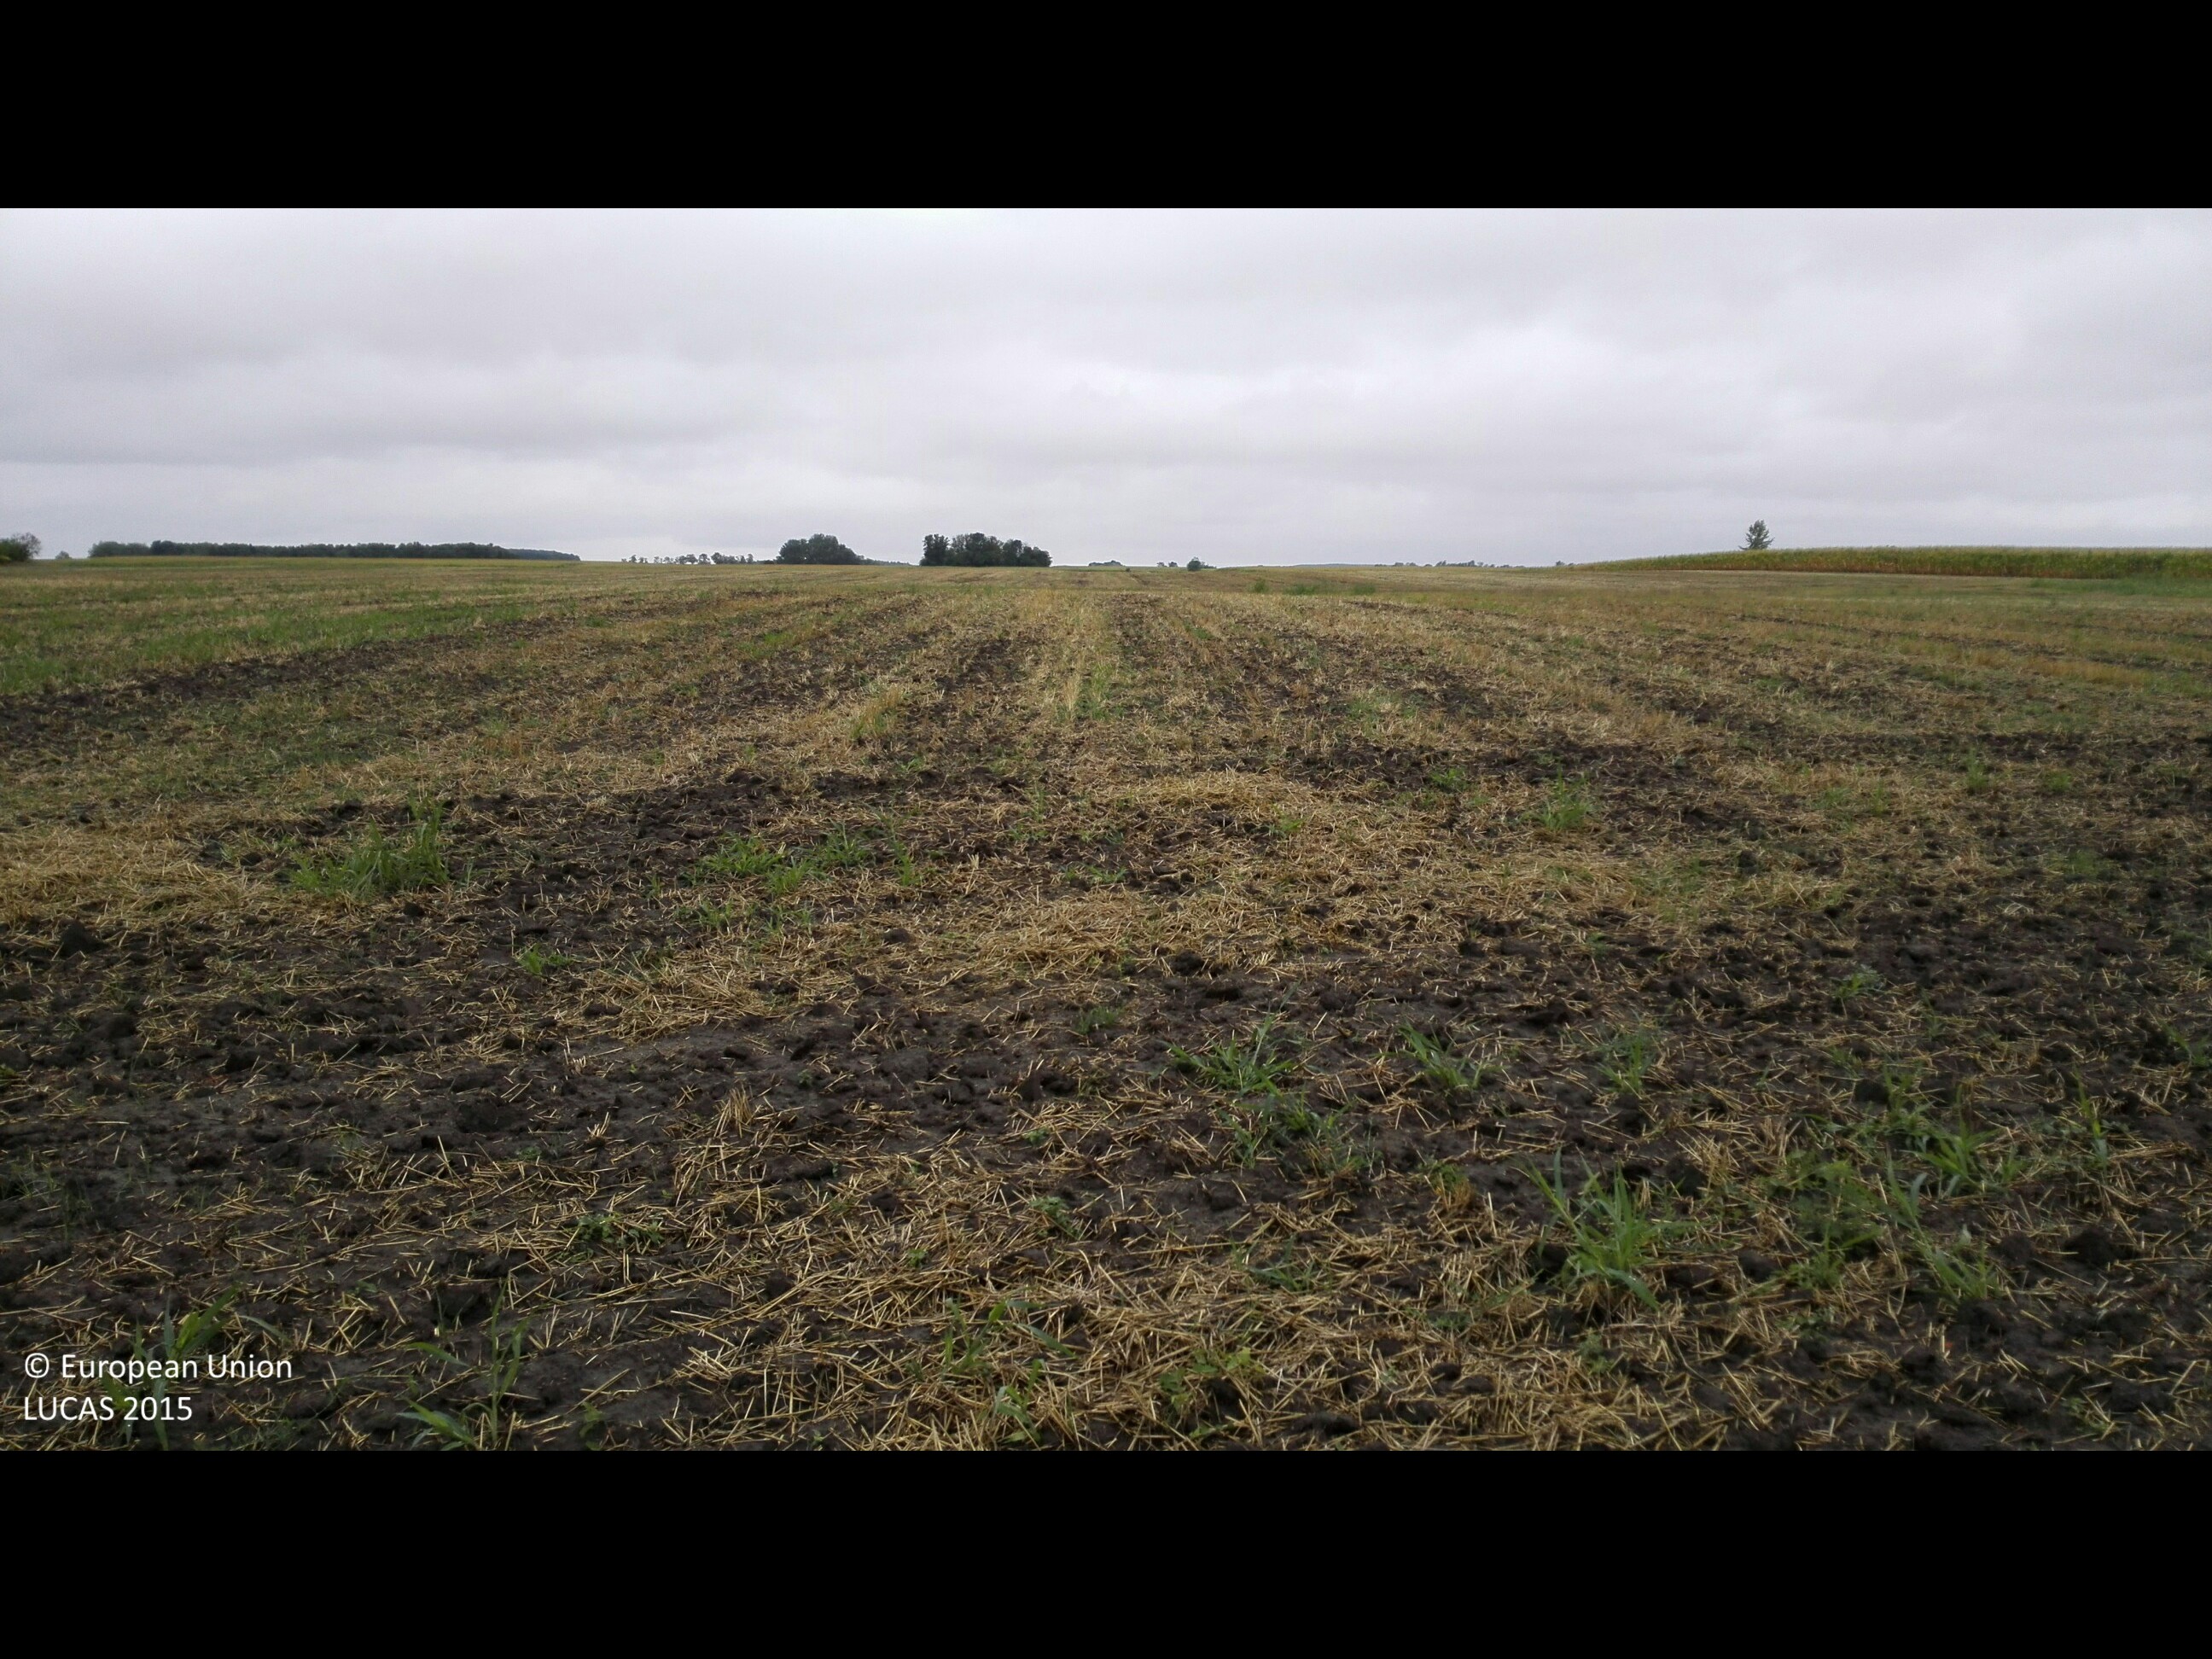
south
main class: Cropland
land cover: Common wheat
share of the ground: 10 - 25 %
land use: Agriculture (excluding fallow land and kitchen gardens)
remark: Harvested field
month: August
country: HU
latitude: 47.3075
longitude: 21.6975
